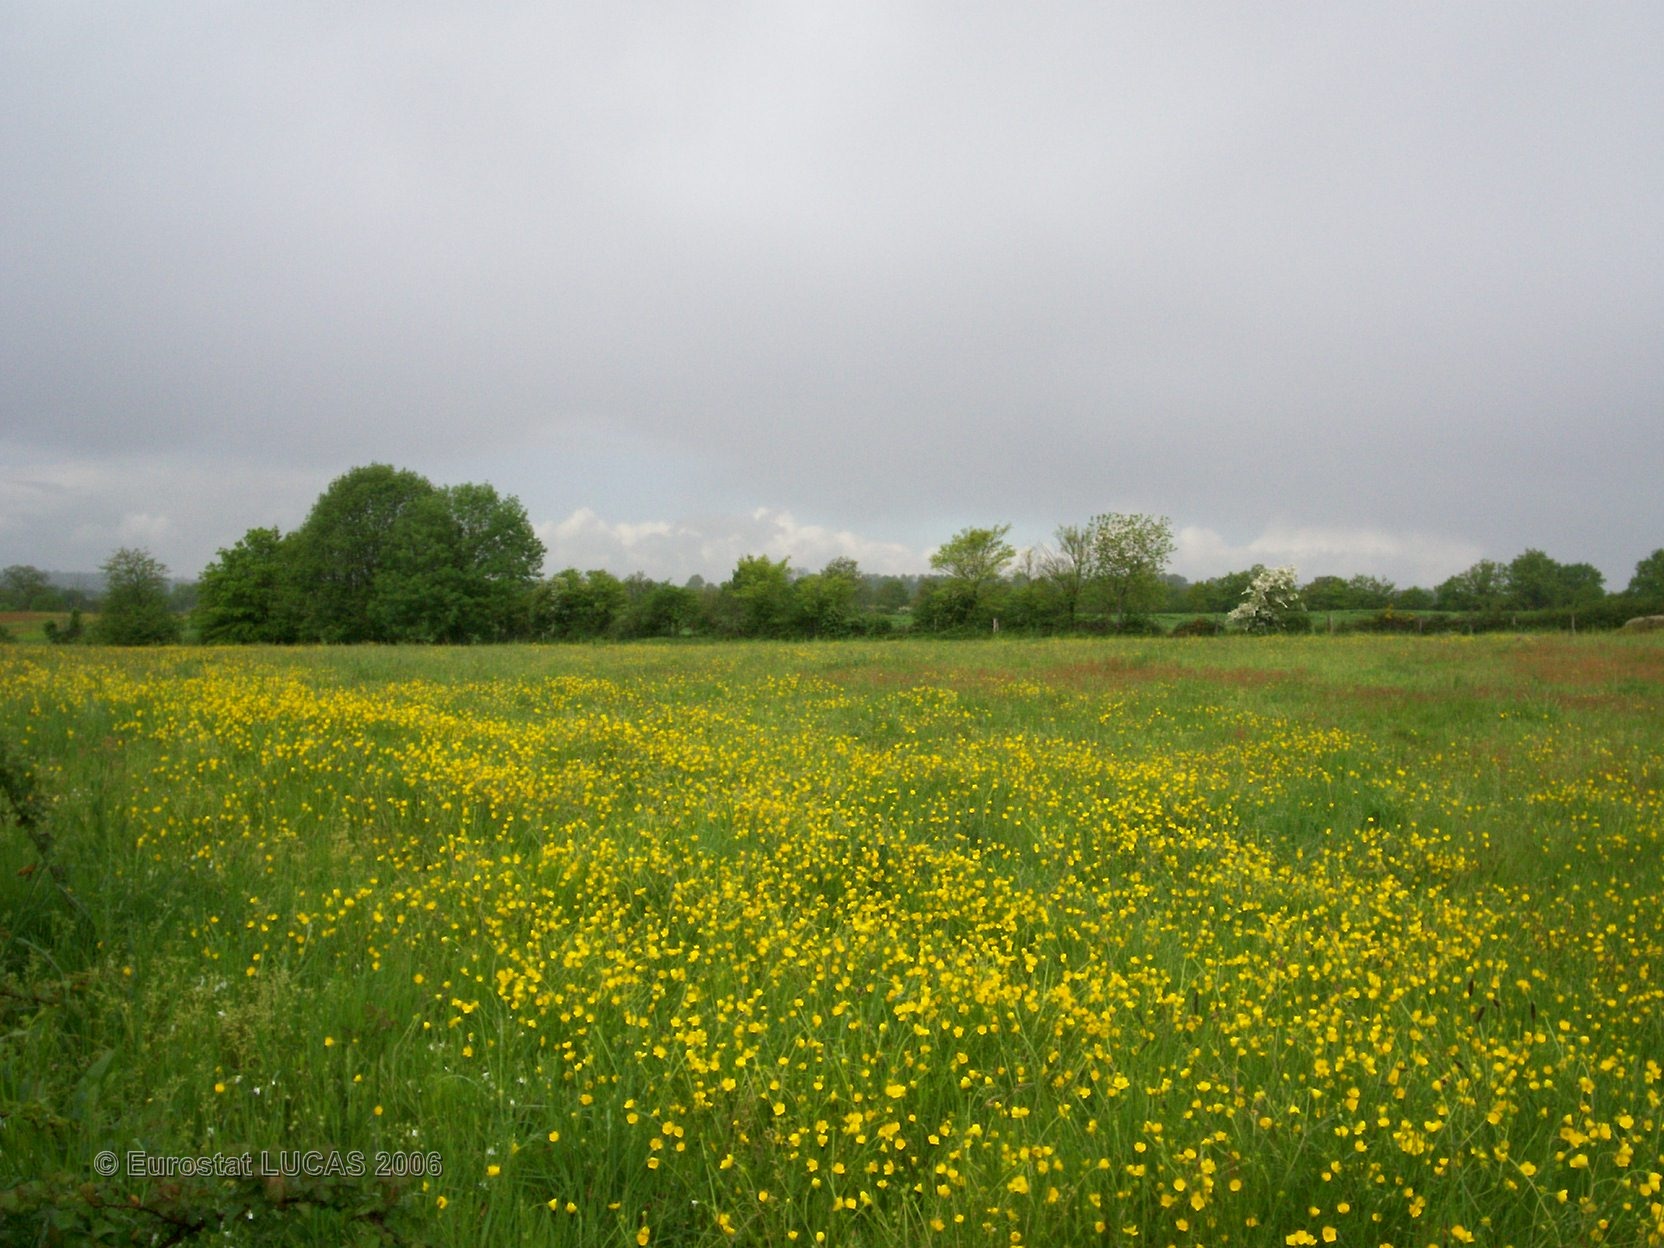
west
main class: Grassland
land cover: Grassland without tree/shrub cover
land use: Agriculture (excluding fallow land and kitchen gardens)
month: May
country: FR
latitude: 46.6301
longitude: -0.3309
